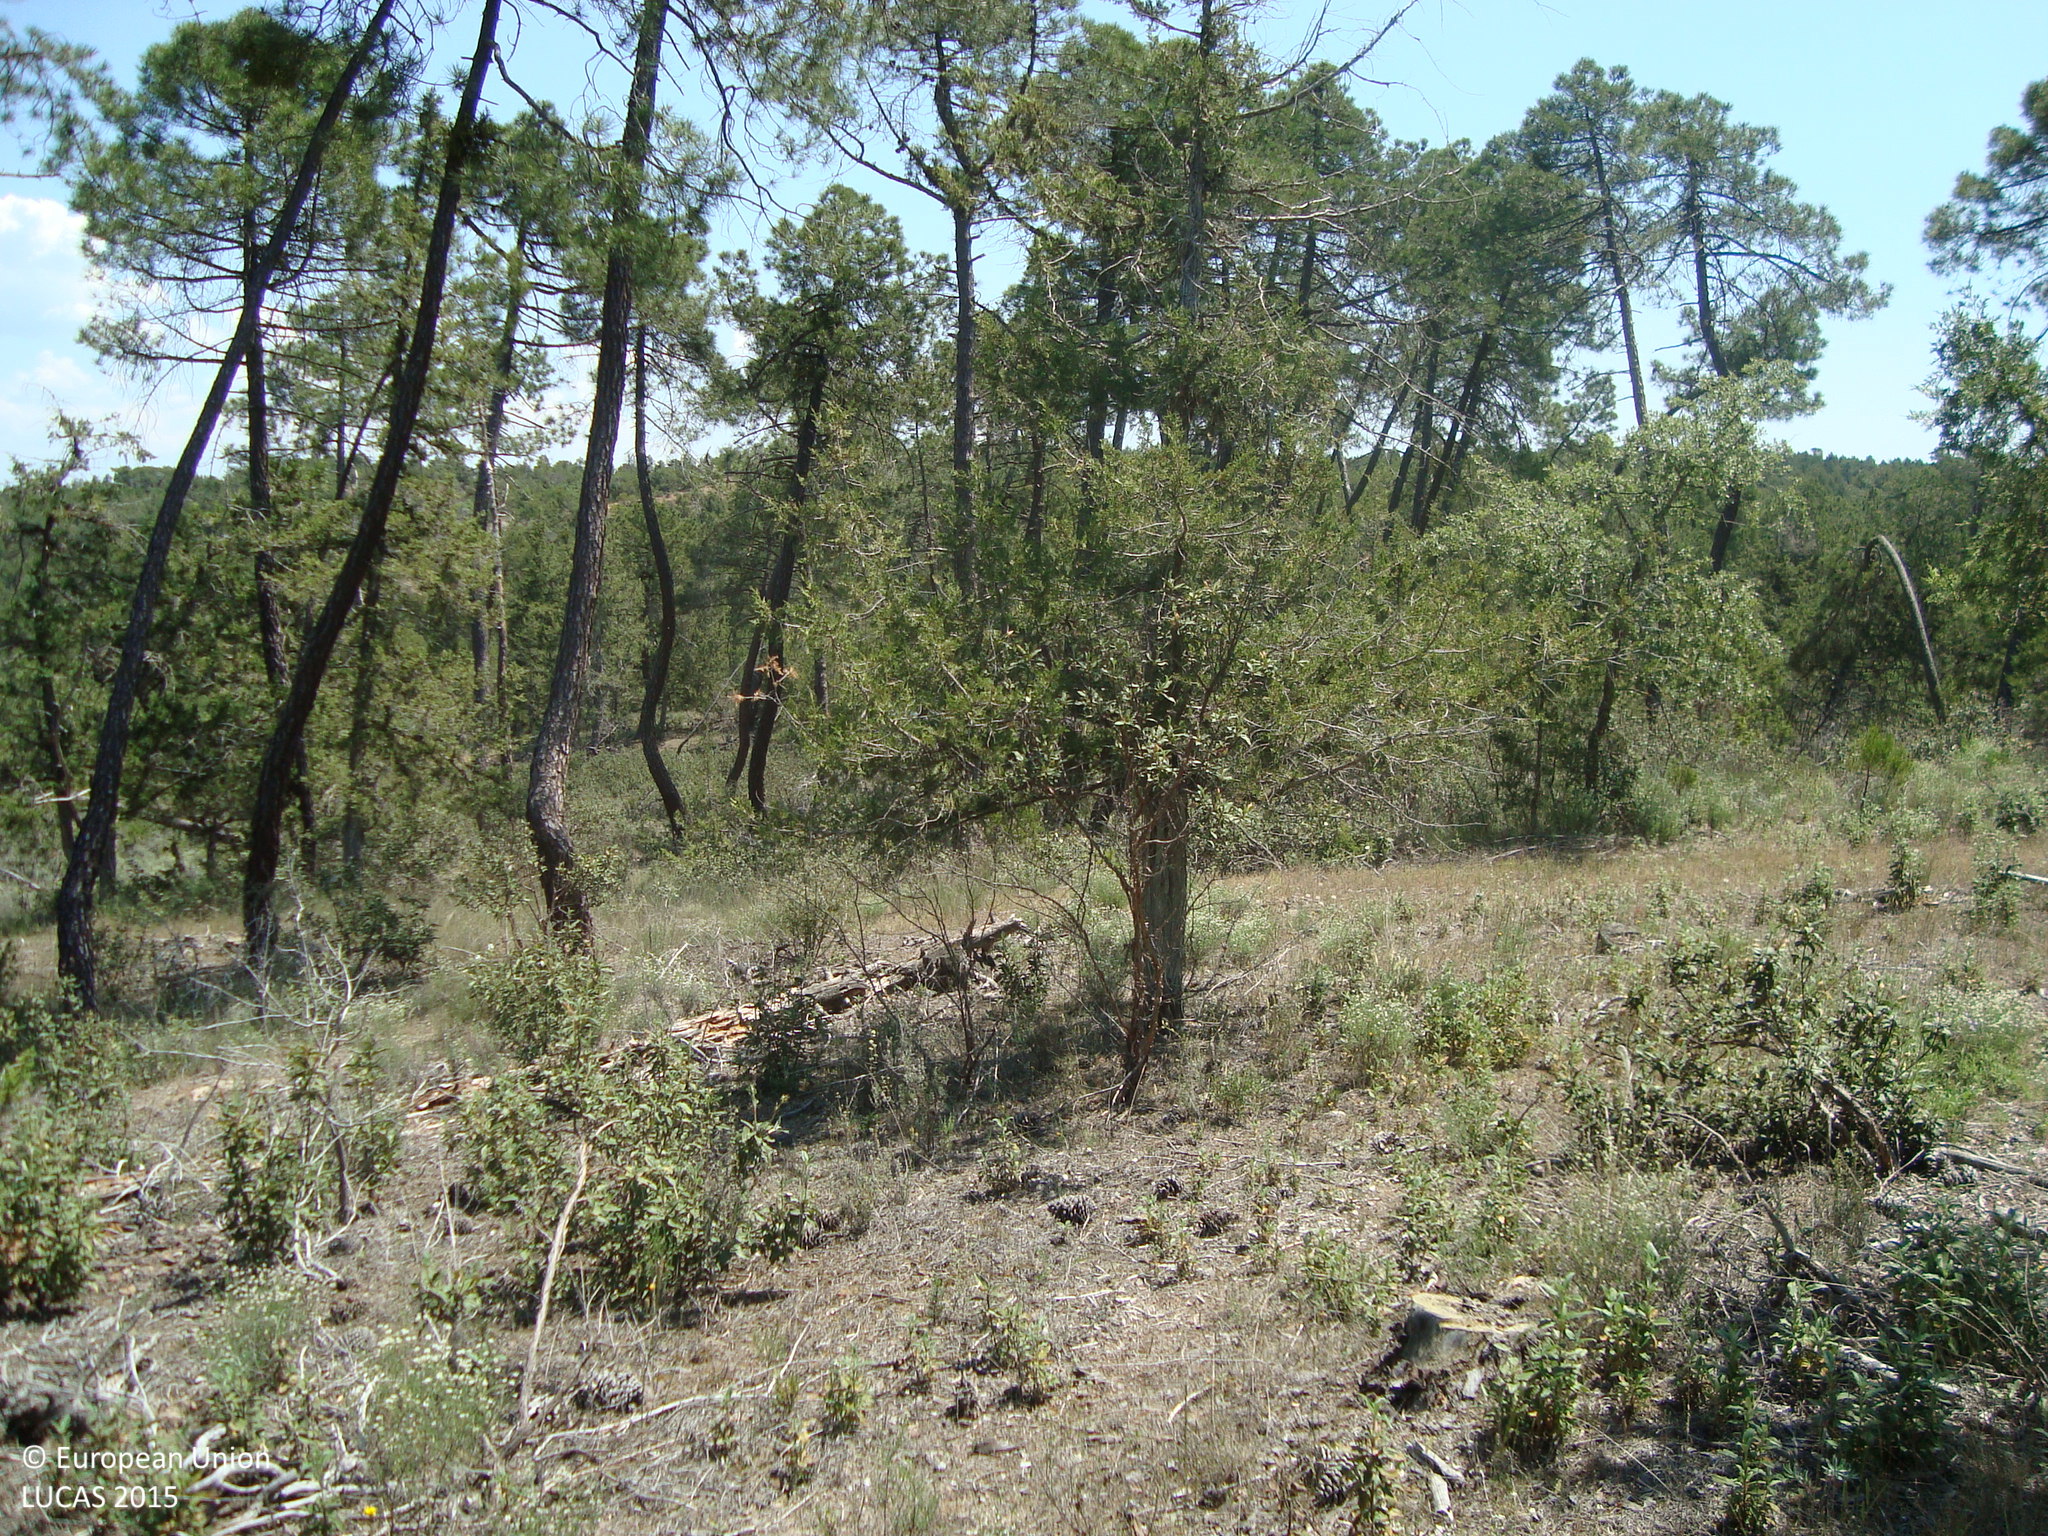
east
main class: Woodland
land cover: Pine dominated coniferous woodland
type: coniferous forest of the mediterranean region
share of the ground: 50 - 75 %
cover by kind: coniferous forest trees 55 %, shrubs 35 %, herbaceous plants 10 %
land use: Forestry
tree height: > 5 m
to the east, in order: Pine dominated coniferous woodland; Tracks; Pine dominated coniferous woodland
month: June
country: ES
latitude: 41.7237
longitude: -3.5265
